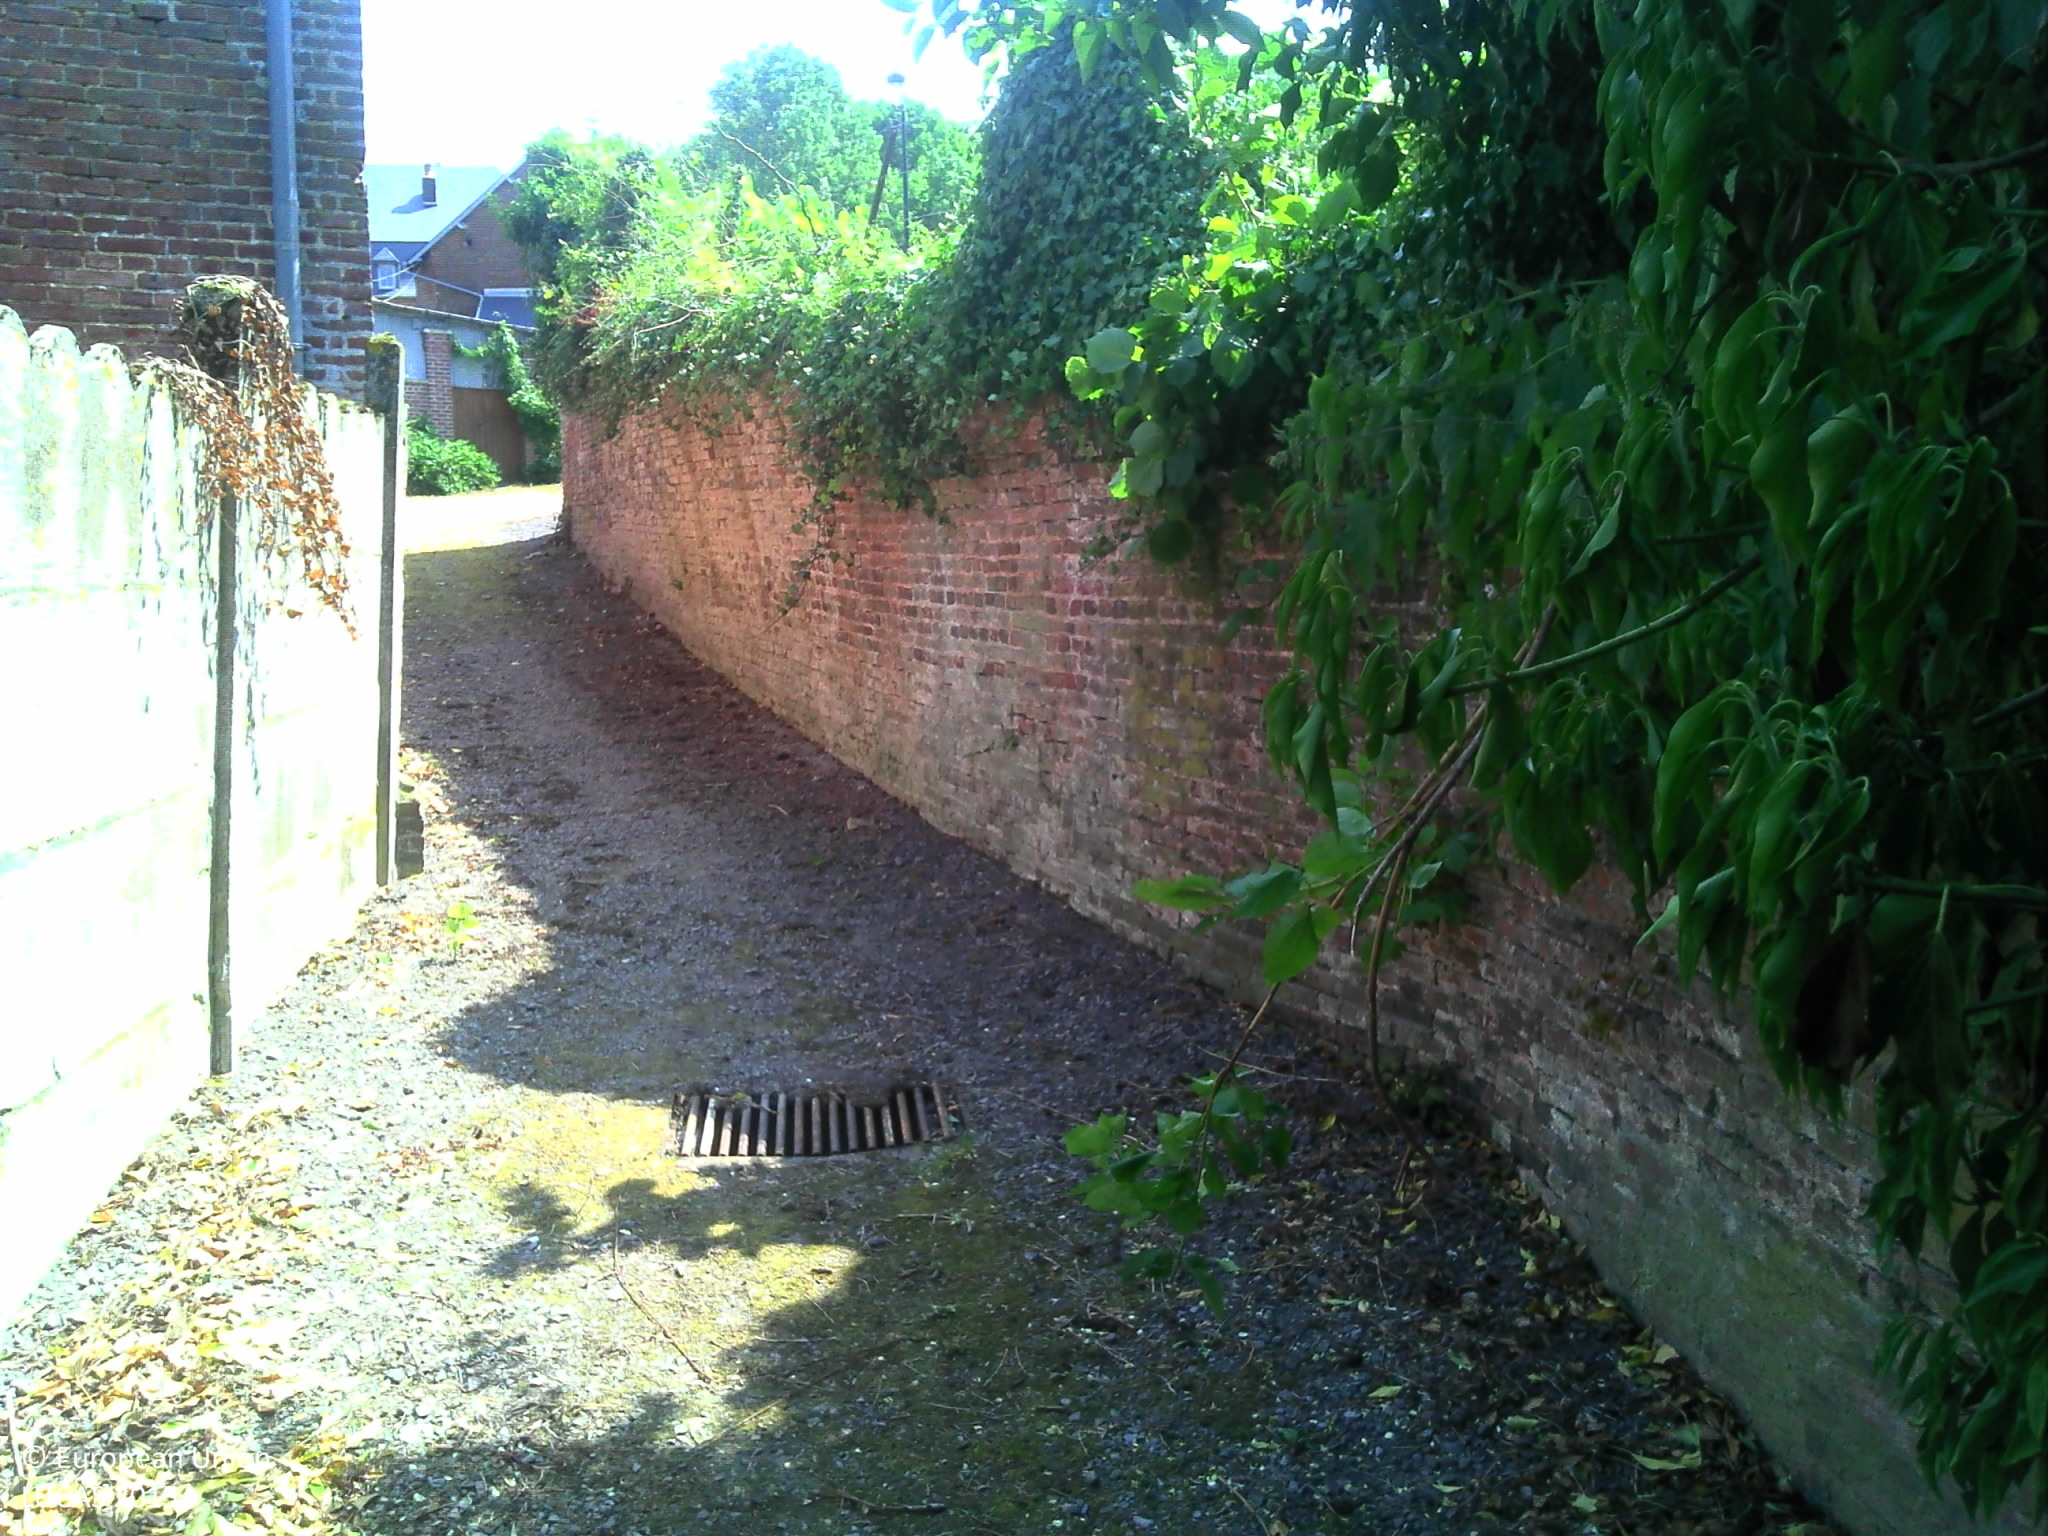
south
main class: Grassland
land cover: Grassland with sparse tree/shrub cover
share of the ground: > 75 %
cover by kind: herbaceous plants 90 %, broadleaved forest trees 5 %, shrubs 5 %
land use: Residential
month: June
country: FR
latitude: 49.7084
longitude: 4.1292
